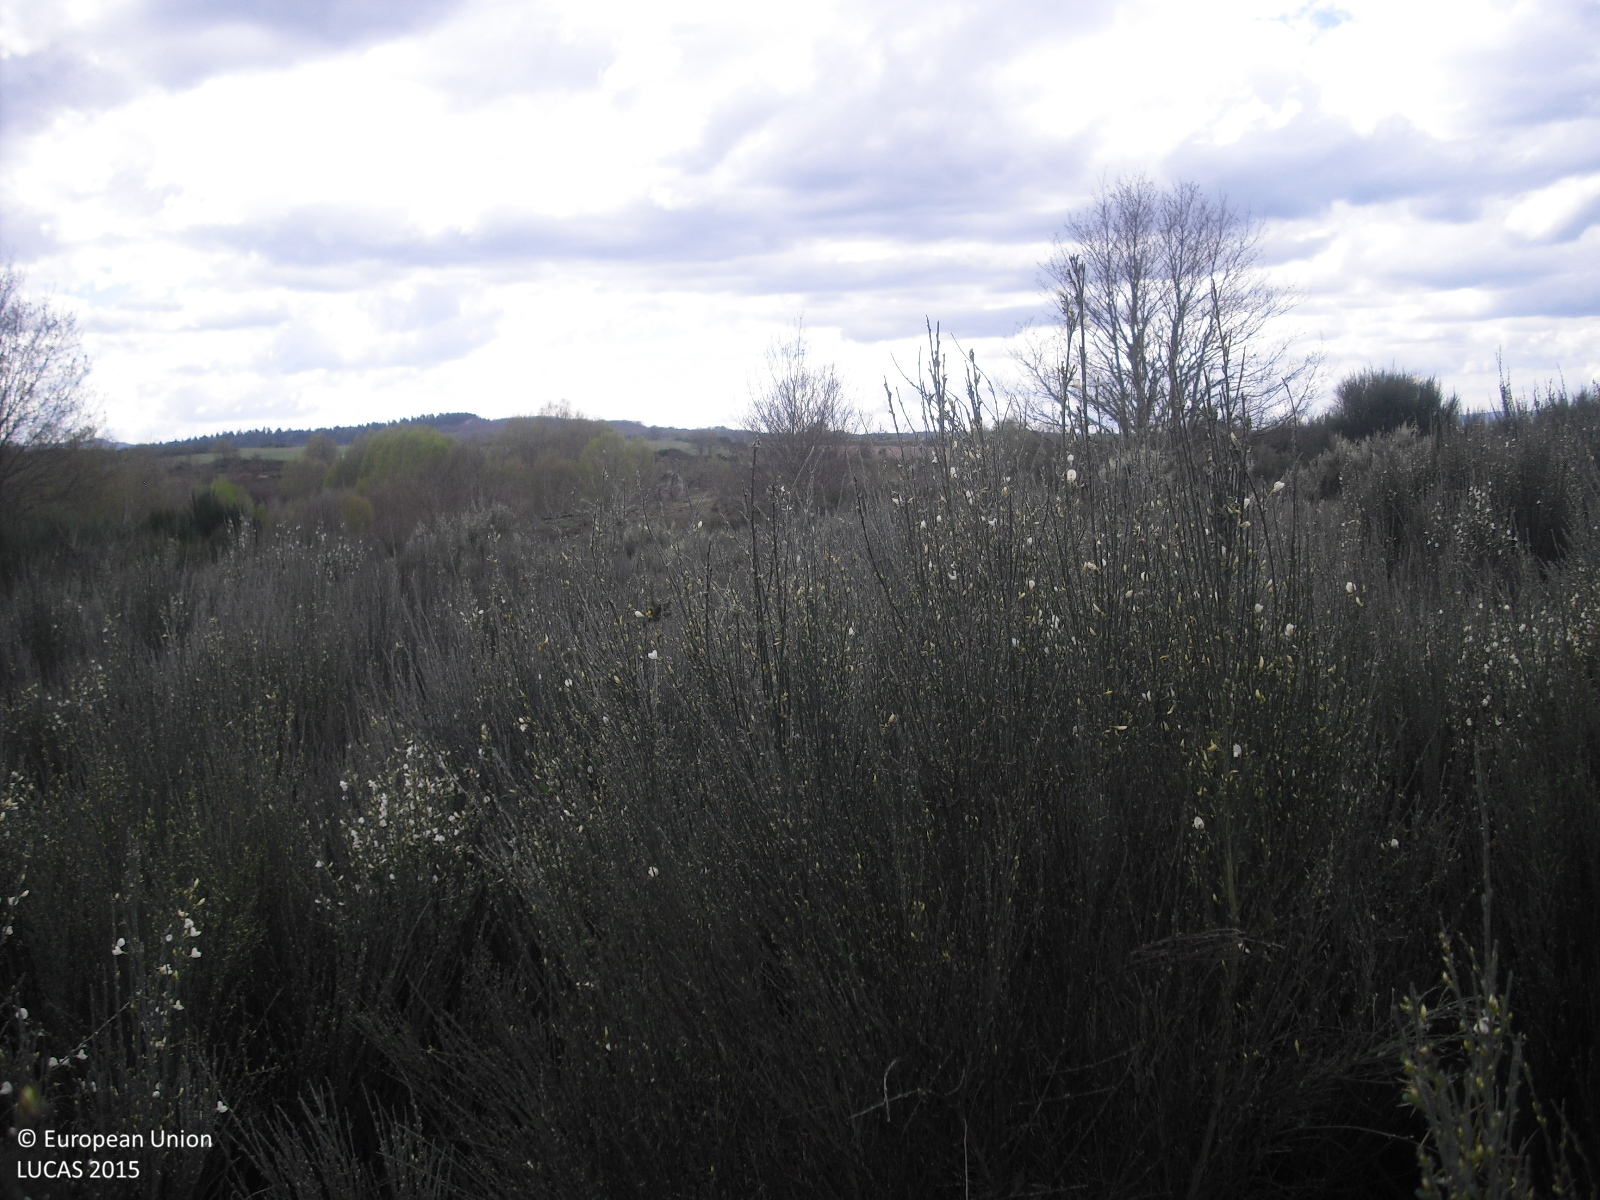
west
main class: Shrubland
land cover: Shrubland with sparse tree cover
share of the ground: > 75 %
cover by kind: shrubs 85 %, herbaceous plants 10 %, broadleaved forest trees 5 %
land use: Abandoned areas
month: April
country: ES
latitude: 41.9543
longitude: -7.8665
